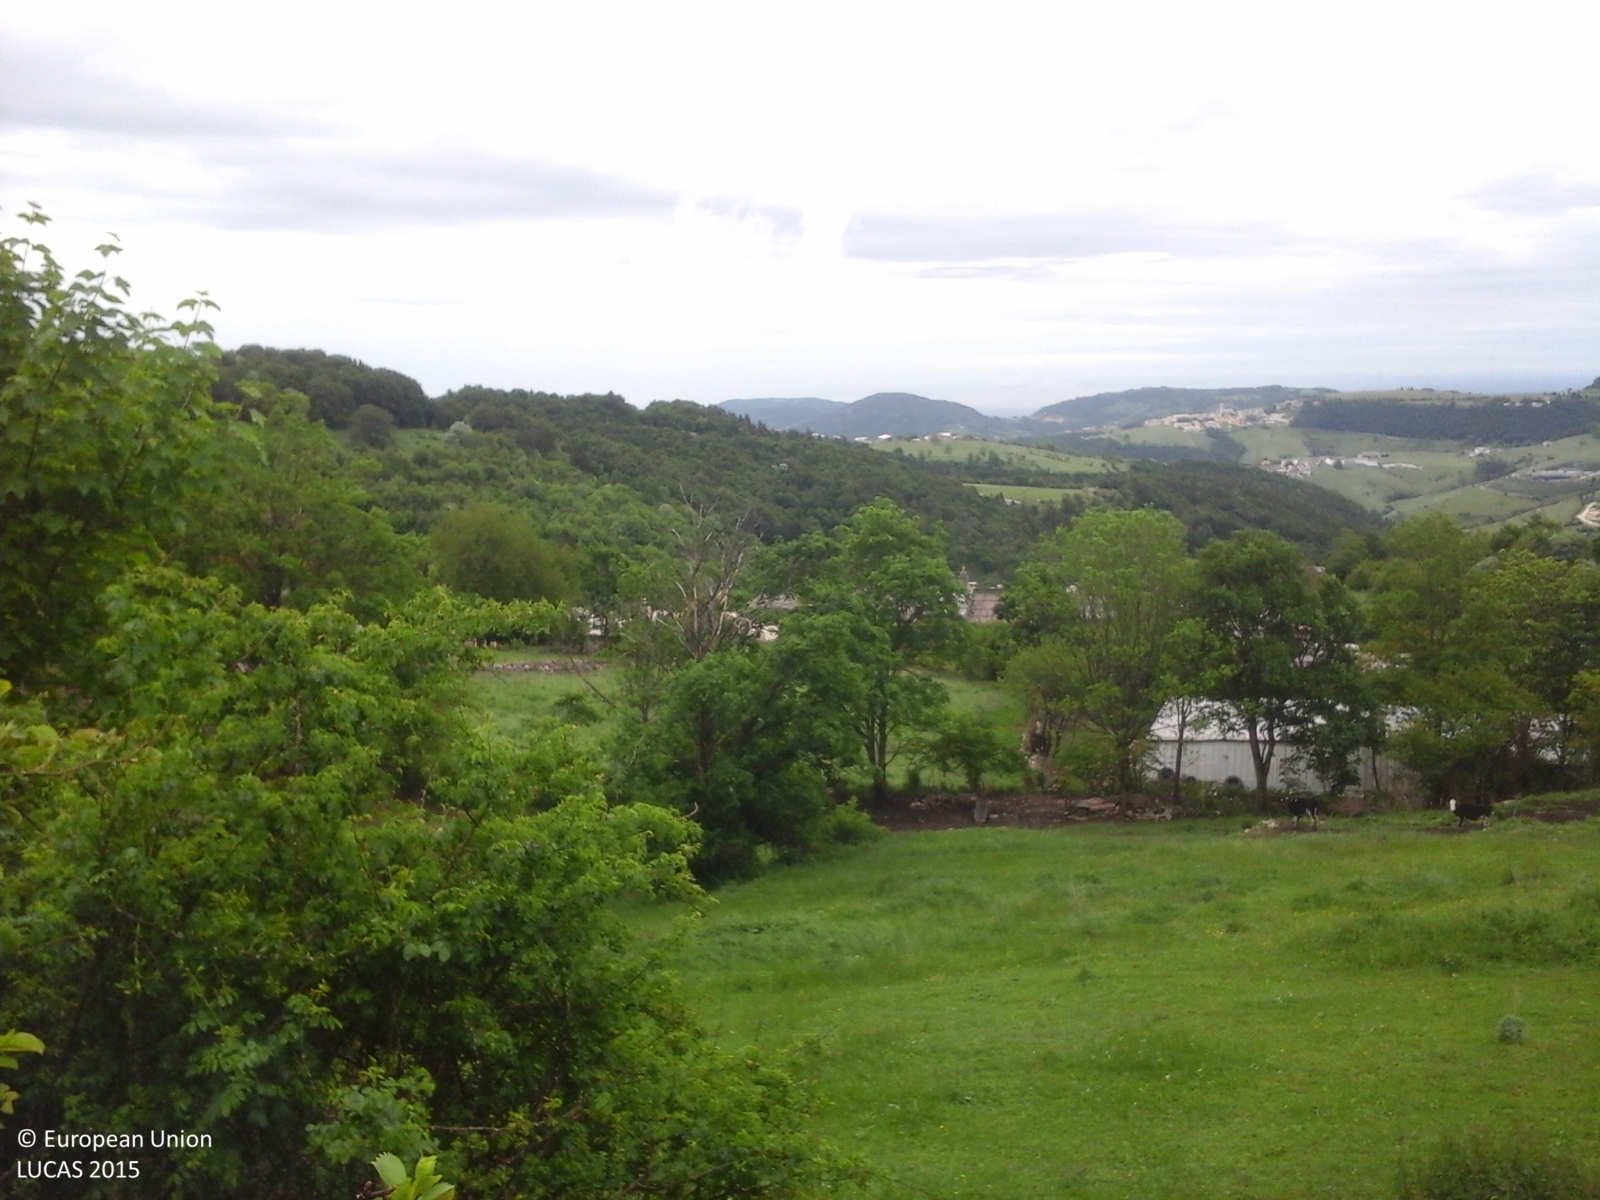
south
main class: Woodland
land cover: Broadleaved woodland
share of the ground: > 75 %
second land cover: Grassland without tree/shrub cover
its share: > 75 %
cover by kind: broadleaved forest trees 45 %, herbaceous plants 45 %, shrubs 10 %
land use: Forestry
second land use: Agriculture (excluding fallow land and kitchen gardens)
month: May
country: IT
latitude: 45.6622
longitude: 10.9610
